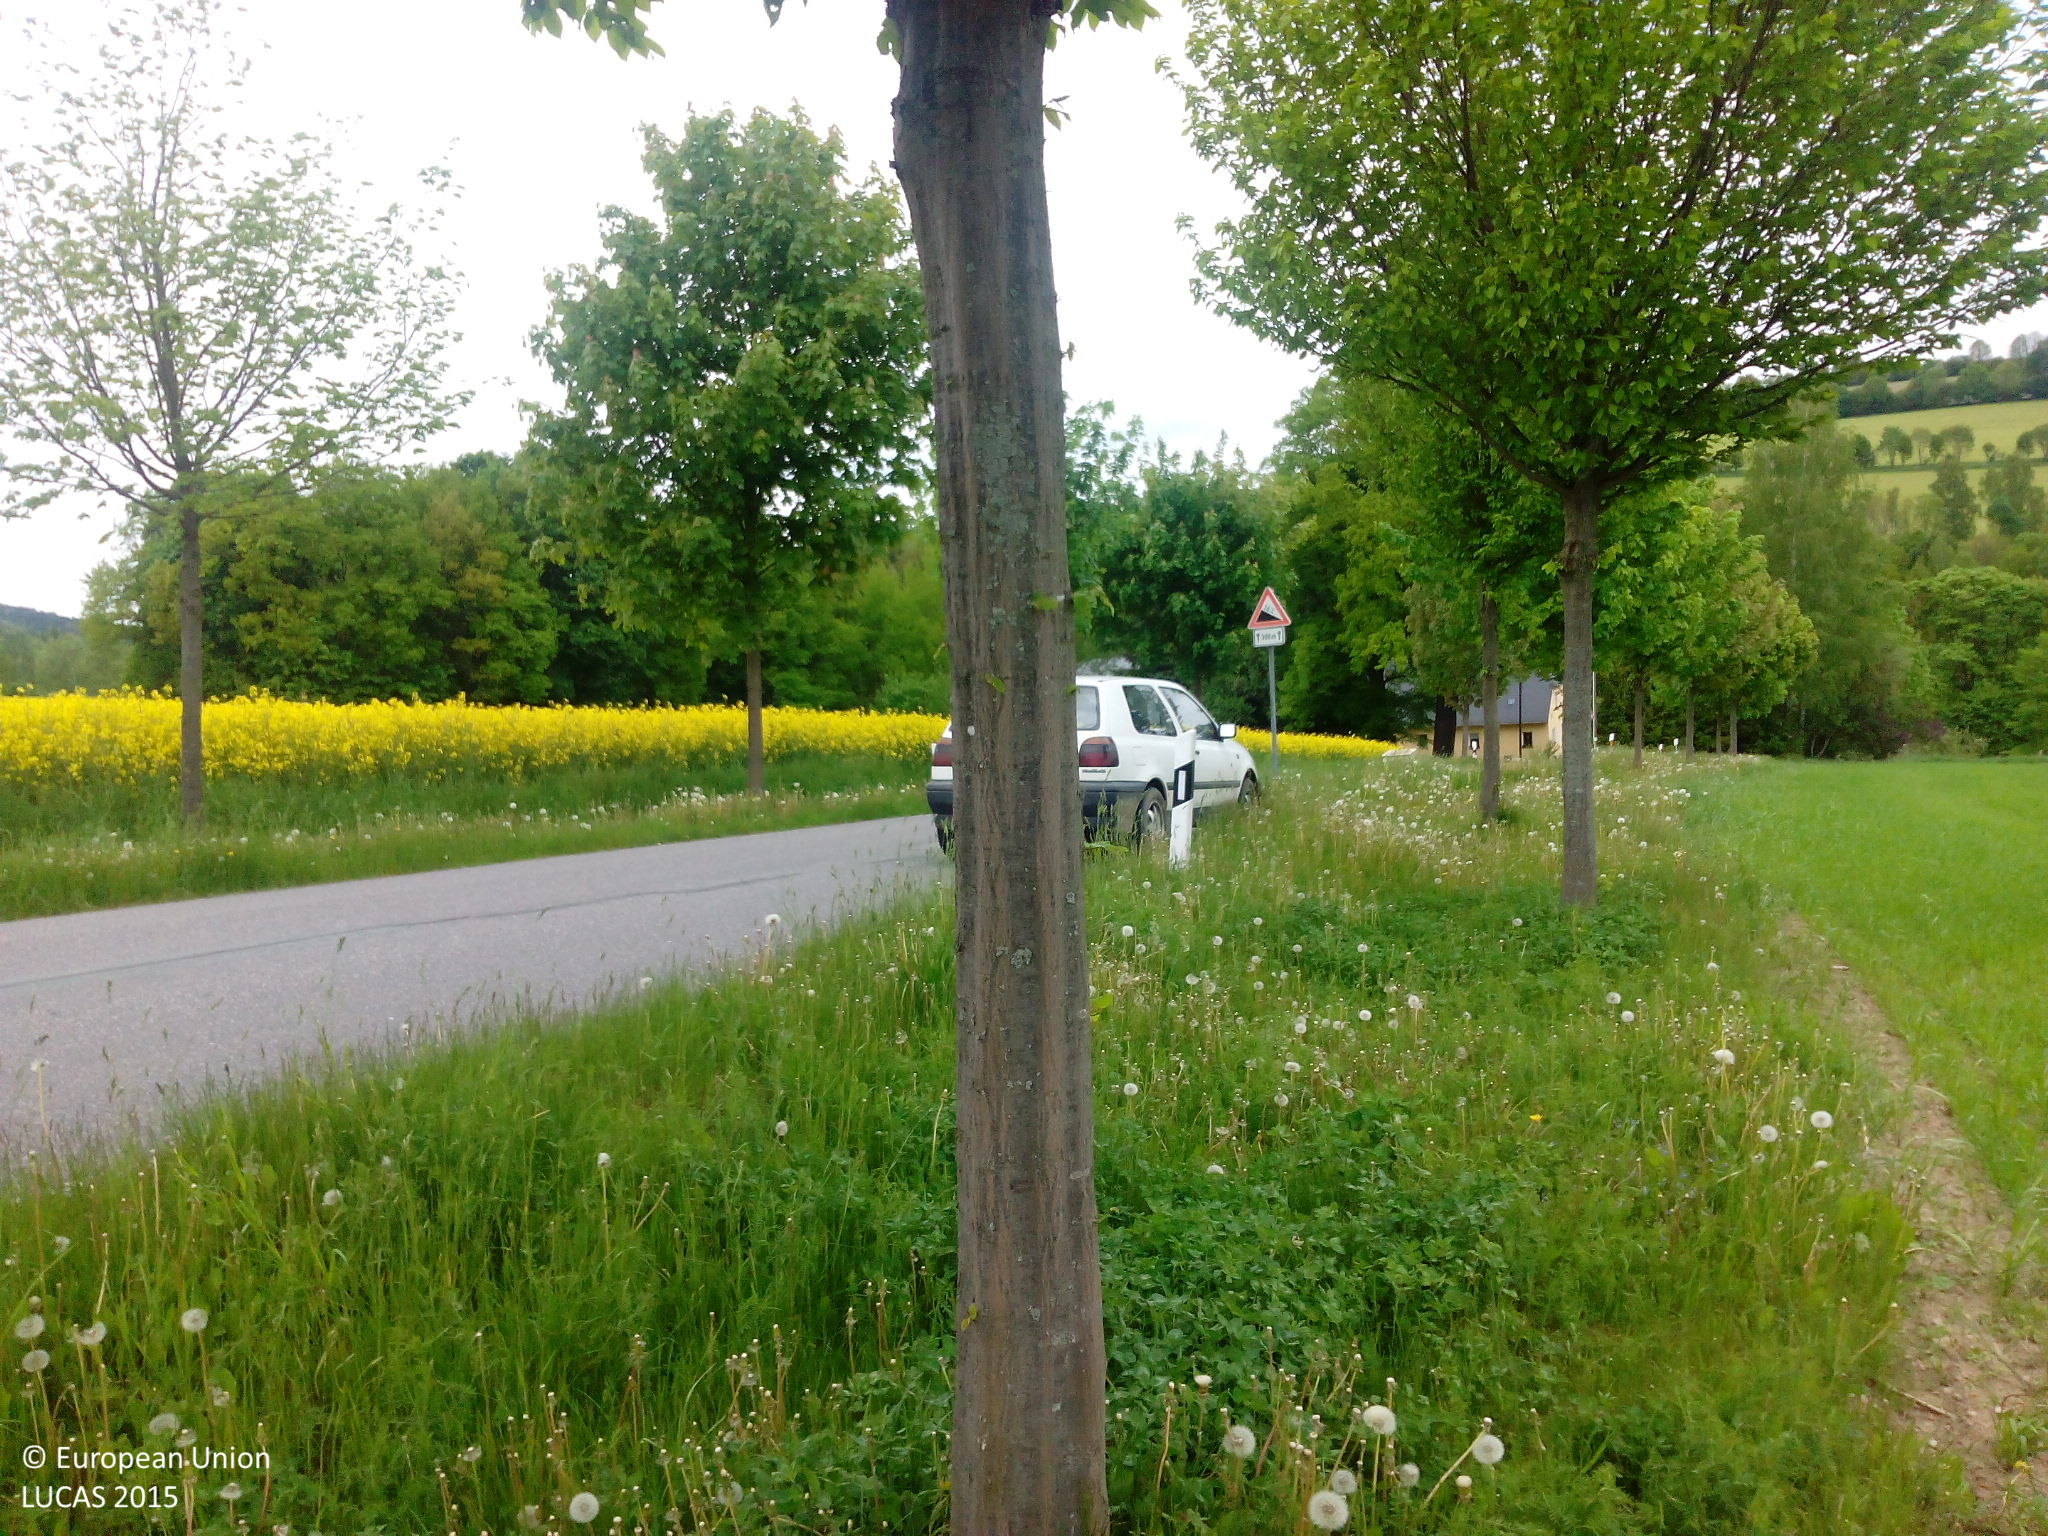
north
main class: Cropland
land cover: Barley
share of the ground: > 75 %
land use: Agriculture (excluding fallow land and kitchen gardens)
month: May
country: DE
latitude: 50.6827
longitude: 13.0713
